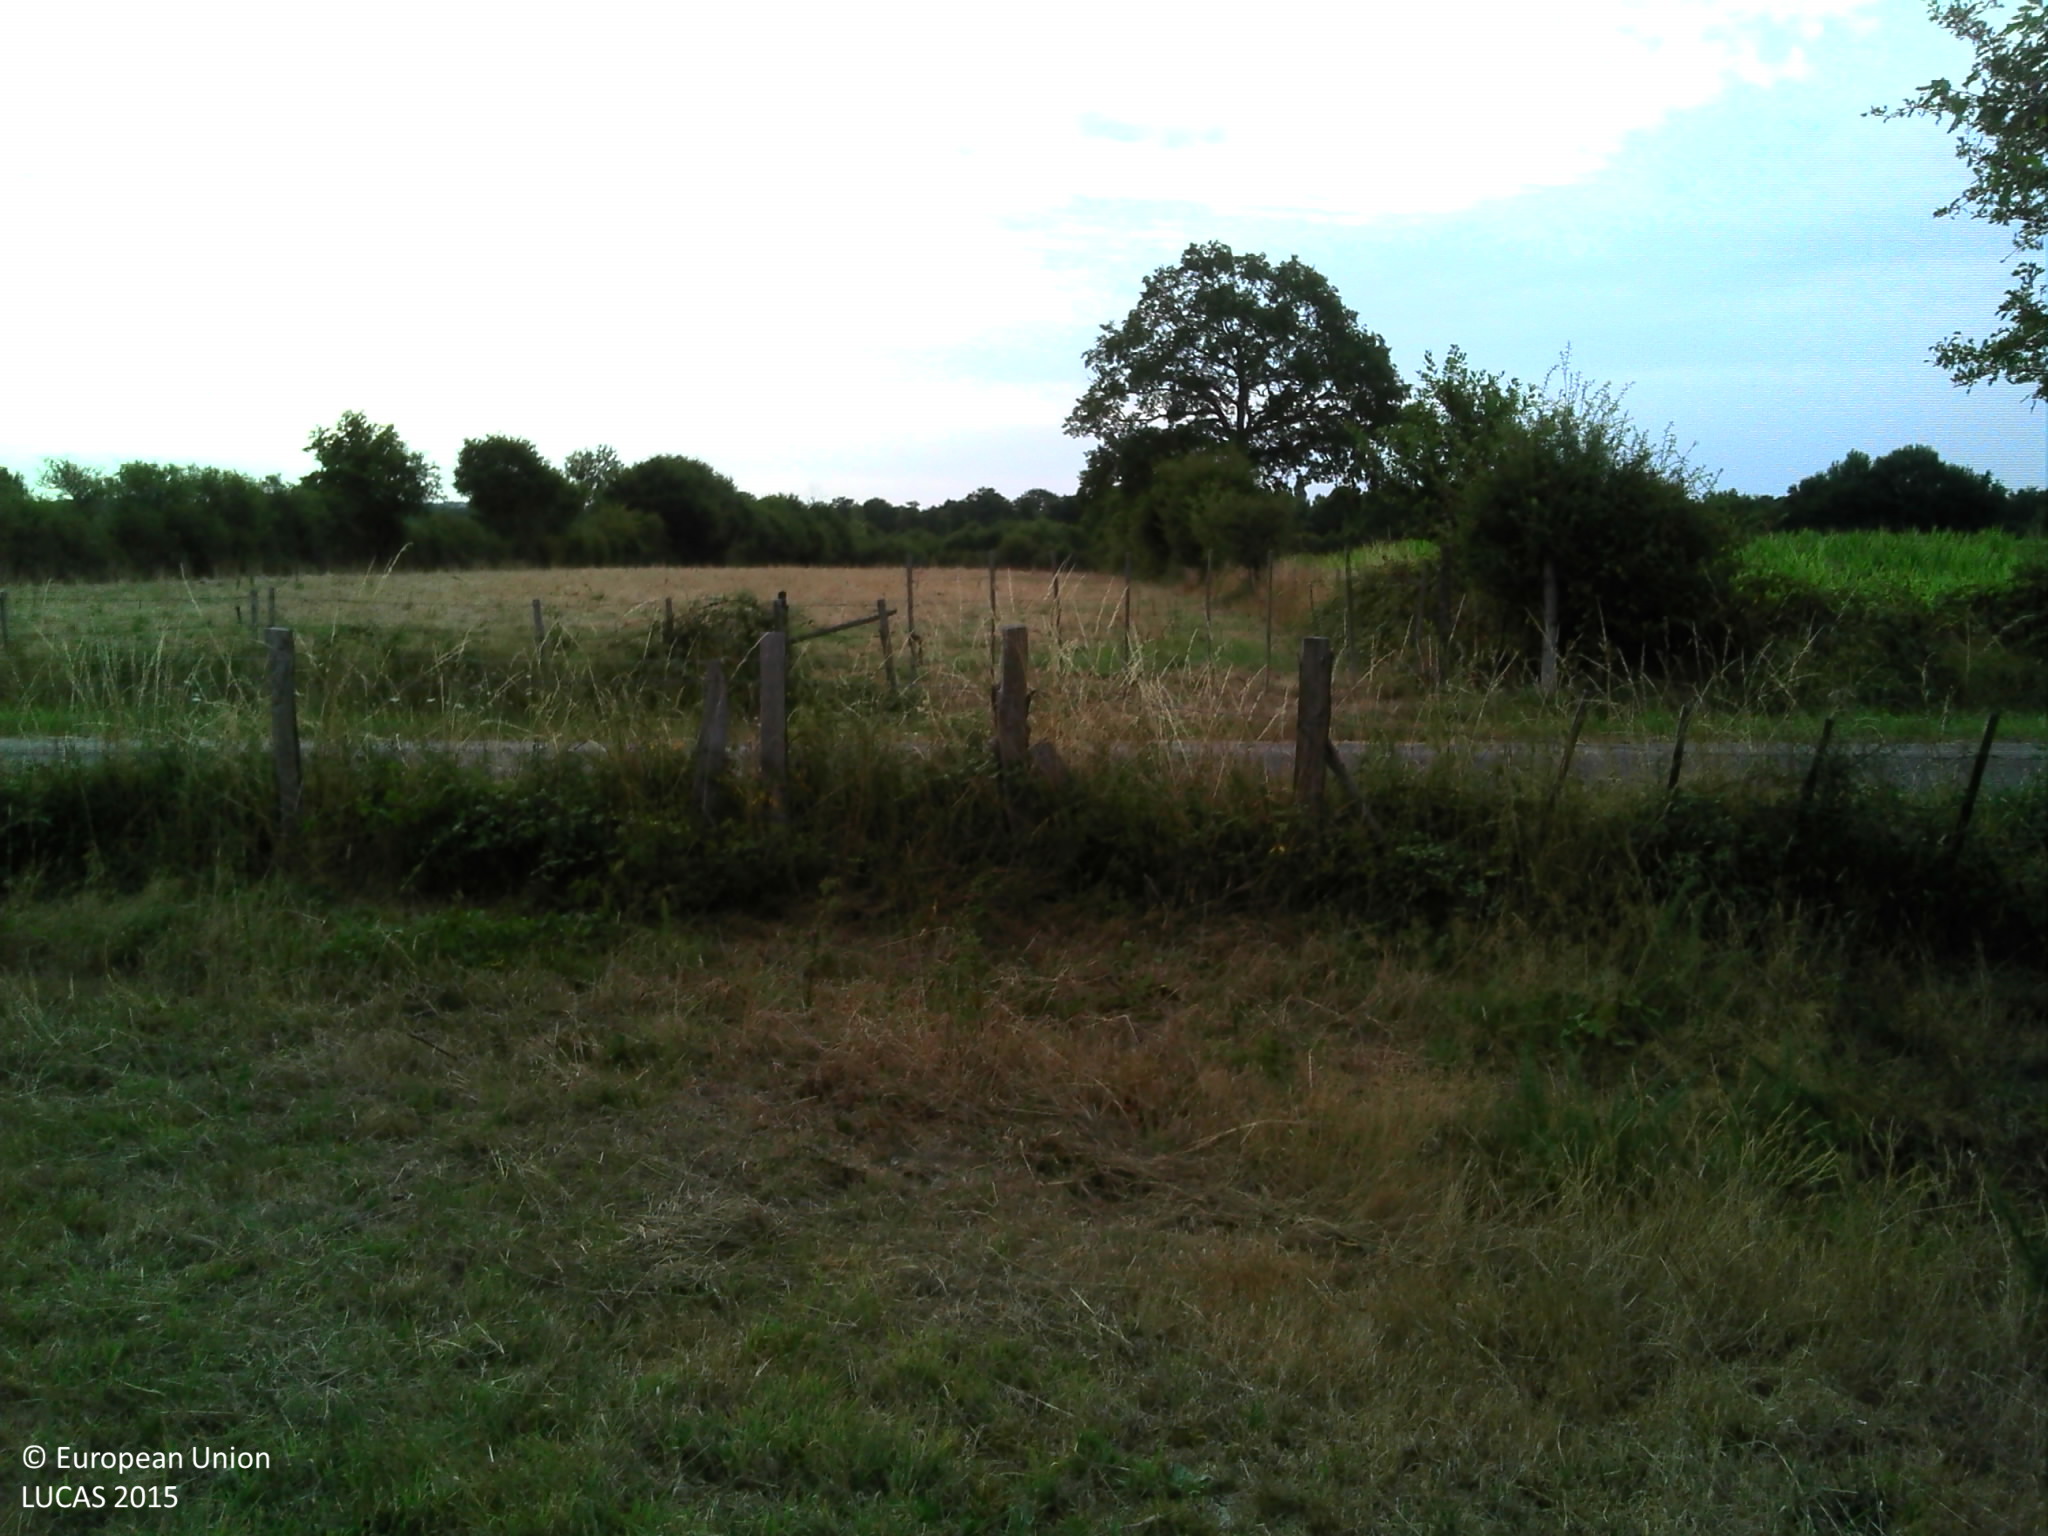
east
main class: Cropland
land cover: Temporary grasslands
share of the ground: > 75 %
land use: Agriculture (excluding fallow land and kitchen gardens)
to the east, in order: Temporary grasslands; Fences; Ditches and canals; Grass margins; Paved roads, cycling and walking lanes; Grass margins; Ditches and canals; Fences; Grassland without tree/shrub cover
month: August
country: FR
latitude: 47.4458
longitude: -1.5946
